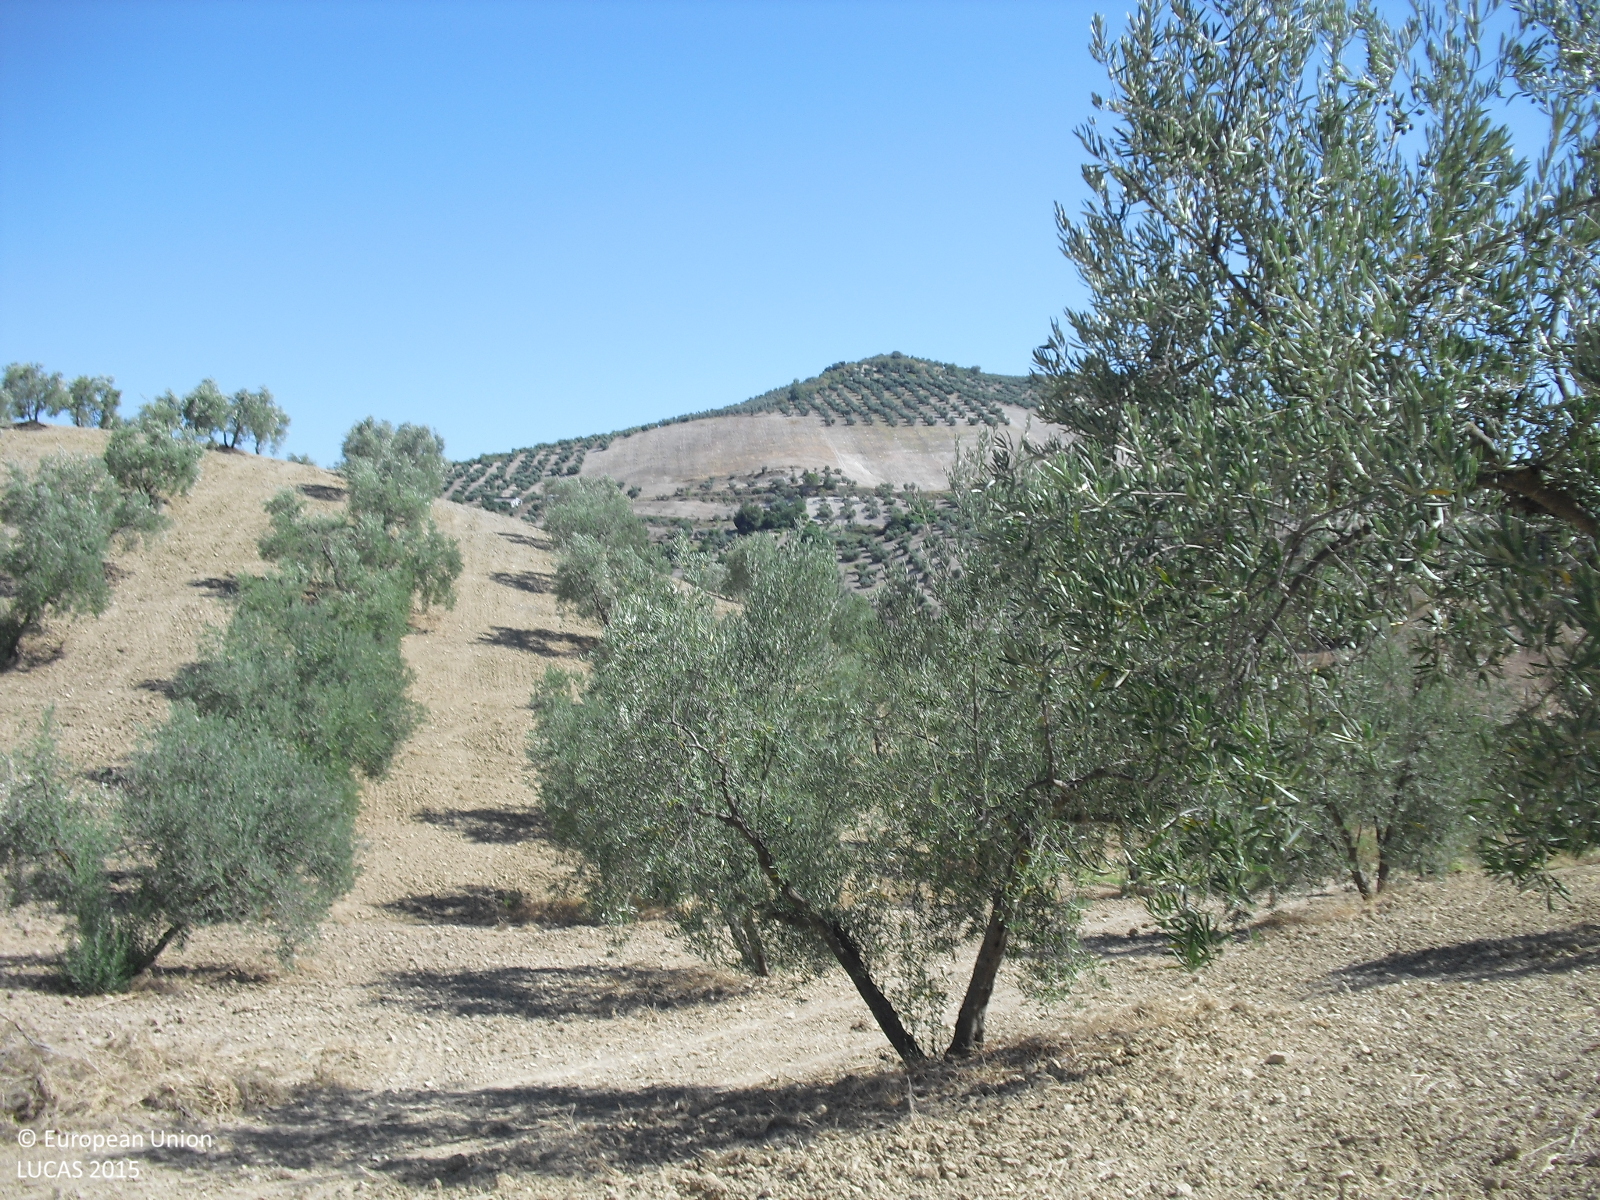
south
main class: Cropland
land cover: Olive groves
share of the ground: 25 - 50 %
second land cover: Other bare soil
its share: > 75 %
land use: Agriculture (excluding fallow land and kitchen gardens)
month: July
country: ES
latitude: 37.0091
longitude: -5.4610
